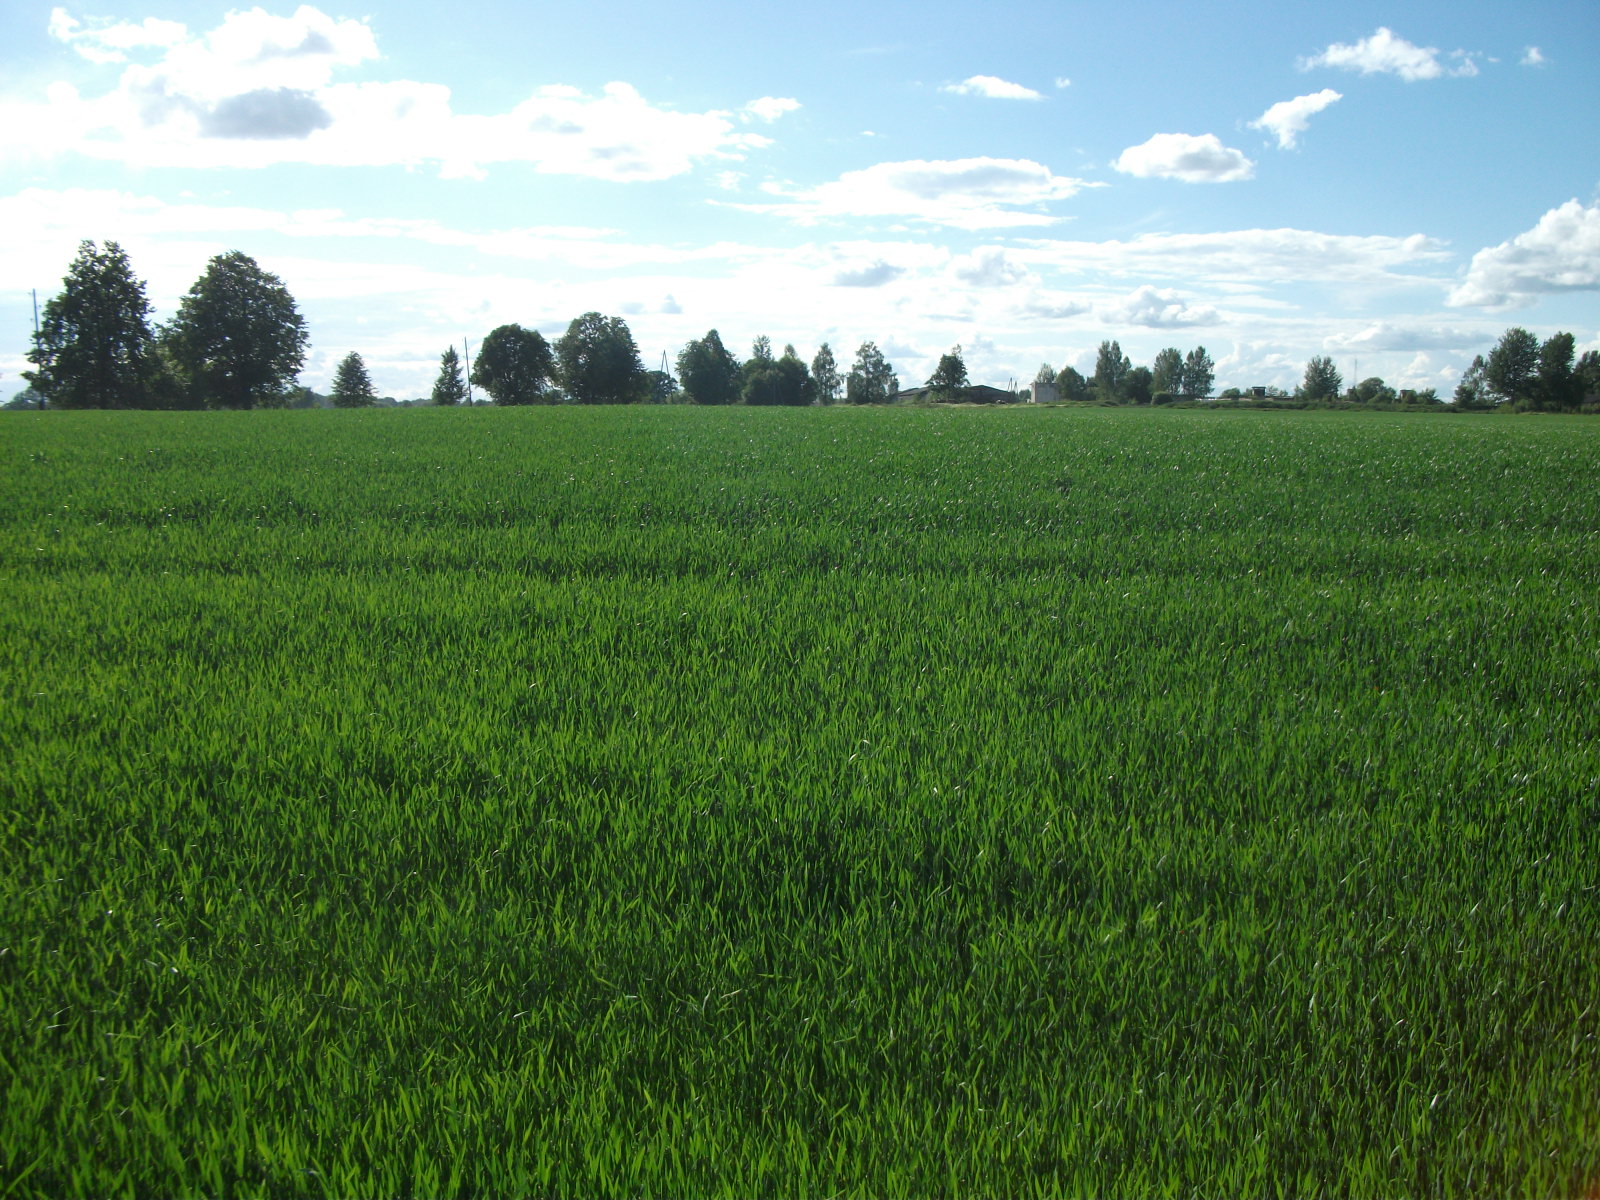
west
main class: Cropland
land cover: Common wheat
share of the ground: > 75 %
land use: Agriculture (excluding fallow land and kitchen gardens)
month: June
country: LV
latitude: 57.0100
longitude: 26.5989
